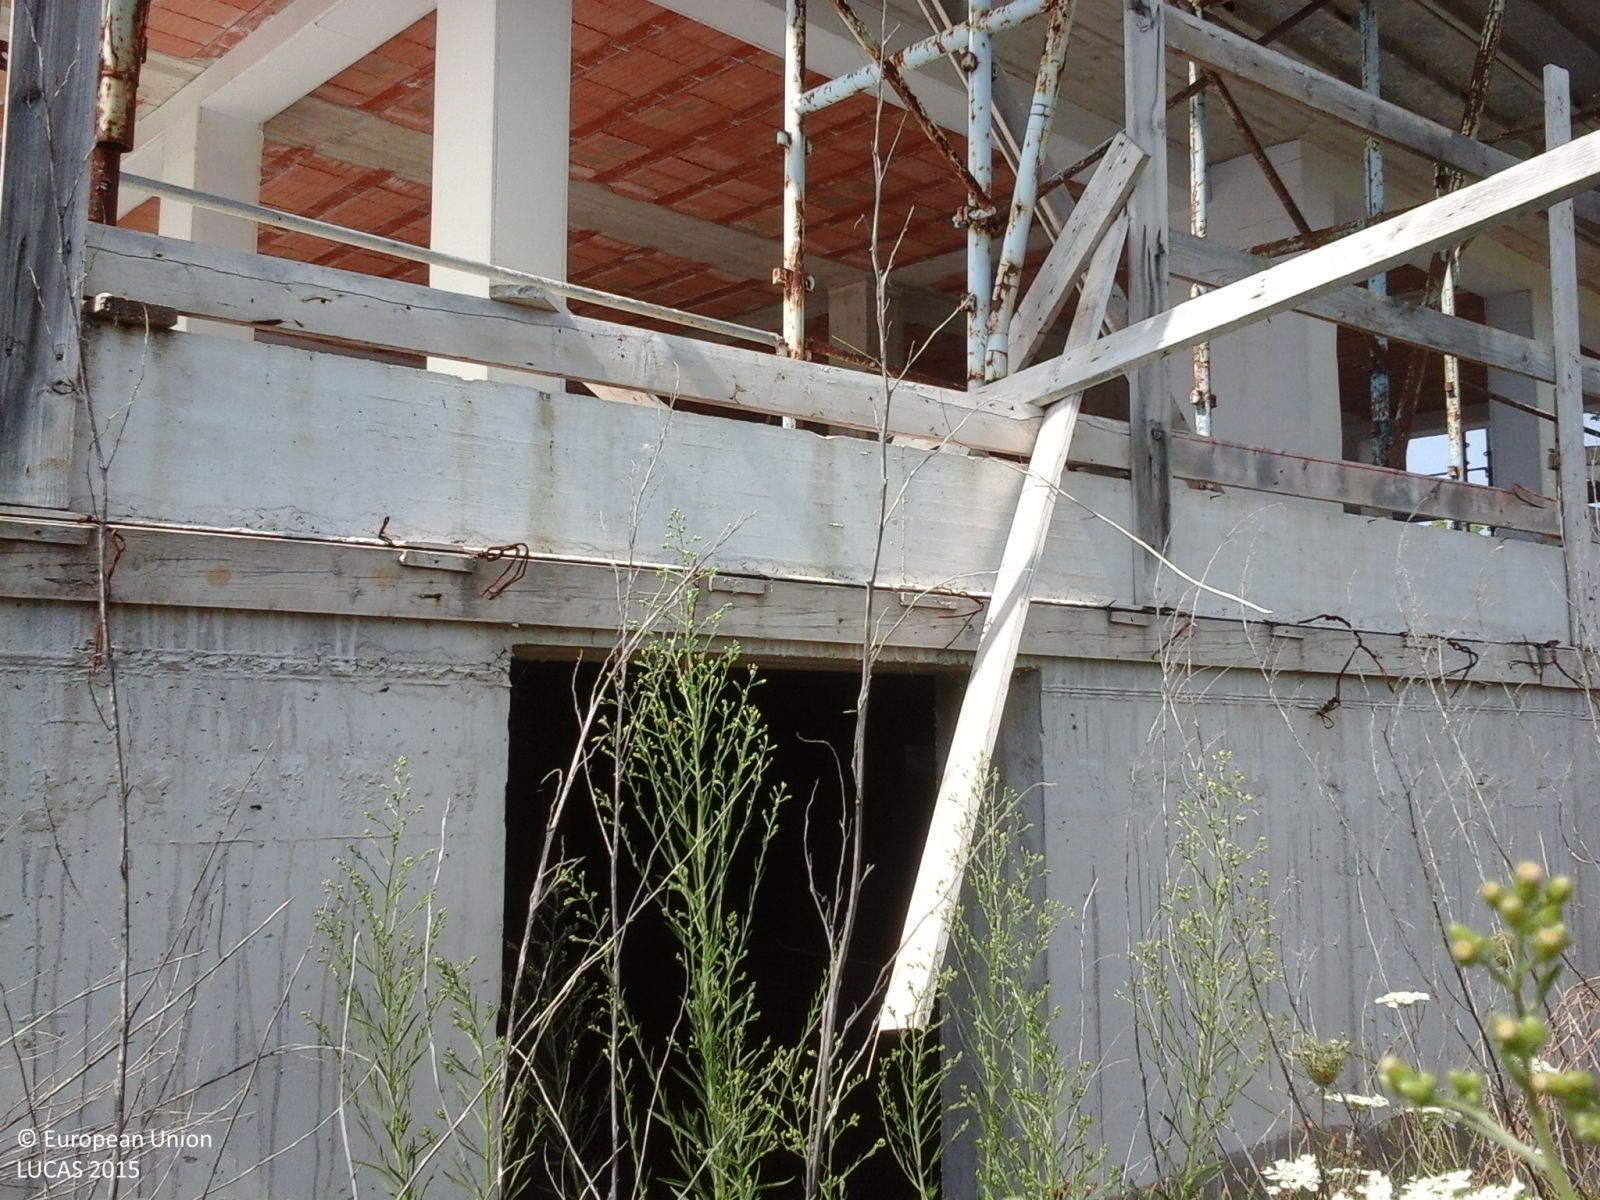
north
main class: Grassland
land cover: Spontaneously vegetated surfaces
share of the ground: > 75 %
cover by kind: herbaceous plants 95 %, shrubs 5 %
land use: Fallow land
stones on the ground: 10 - 25 %
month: August
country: IT
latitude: 43.2365
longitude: 13.1809
